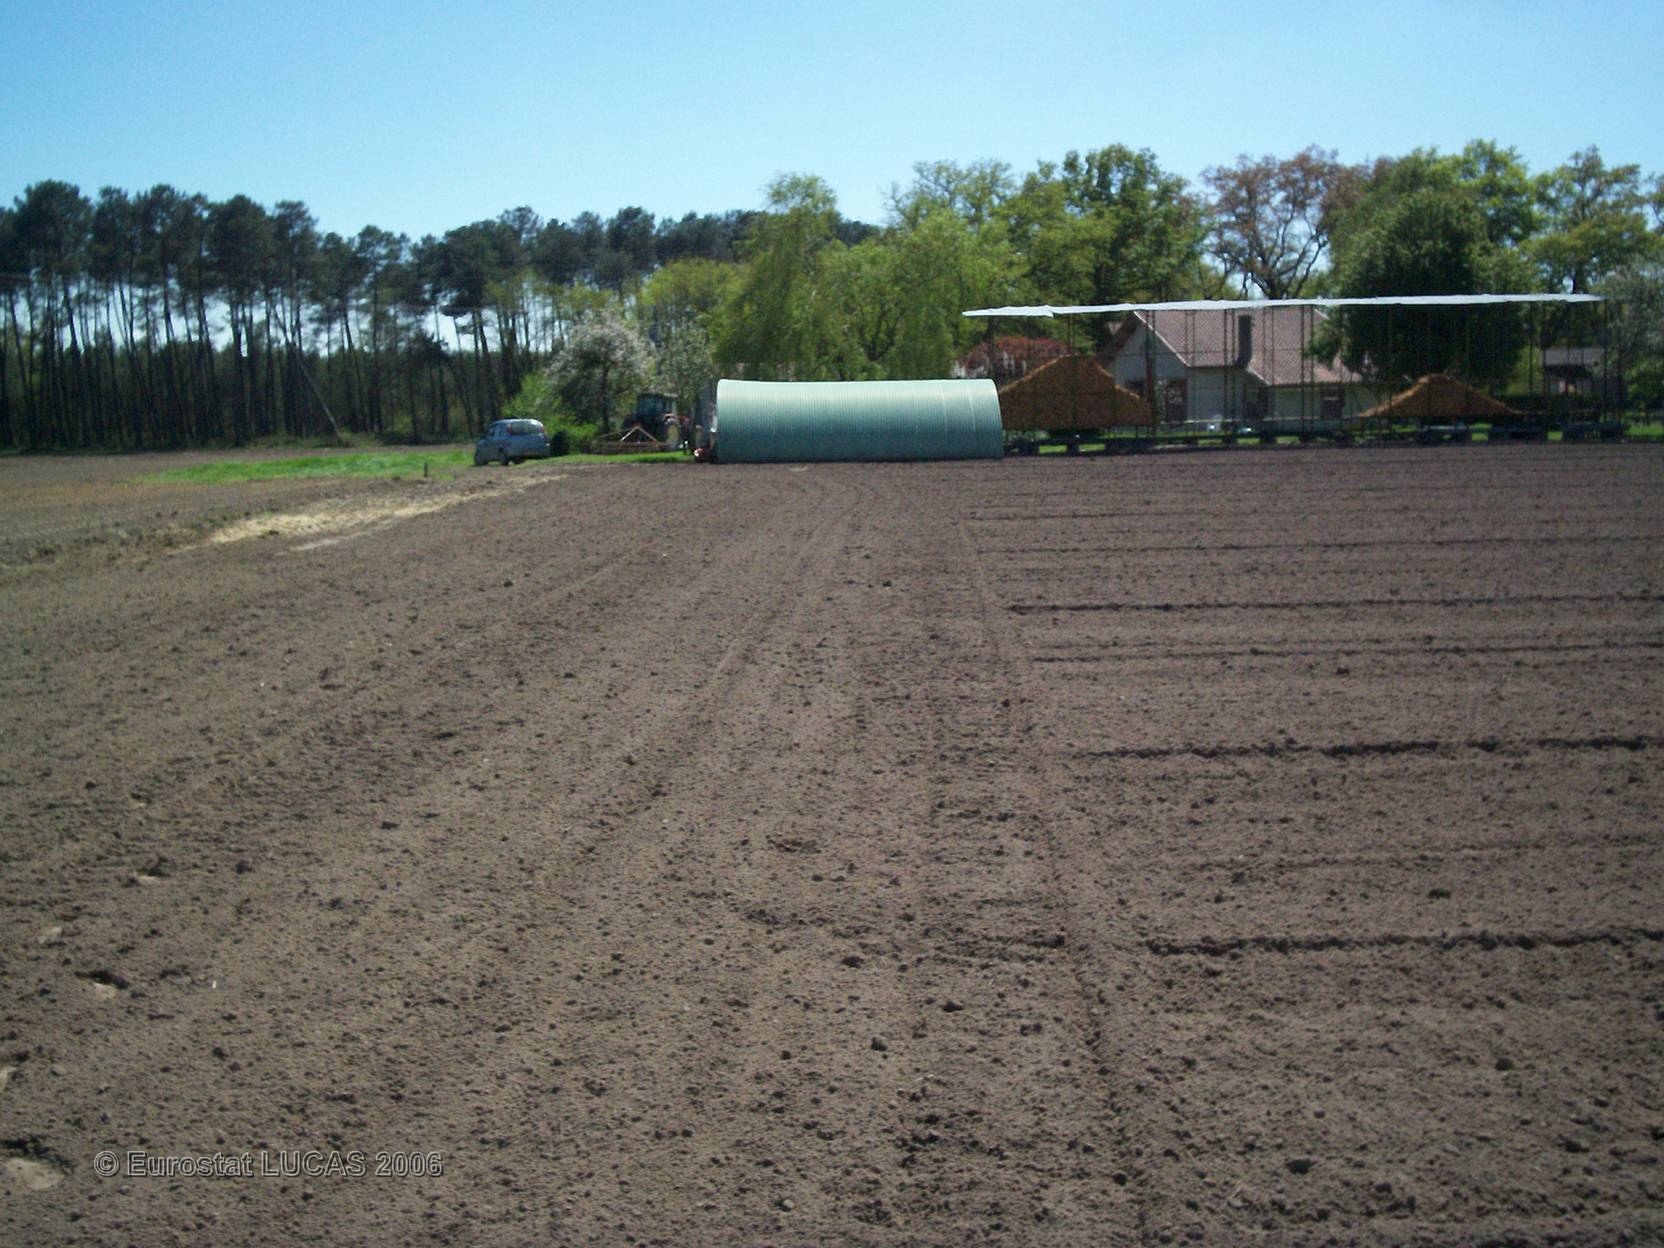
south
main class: Cropland
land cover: Maize
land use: Agriculture (excluding fallow land and kitchen gardens)
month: June
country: FR
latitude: 43.8300
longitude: -0.7203
